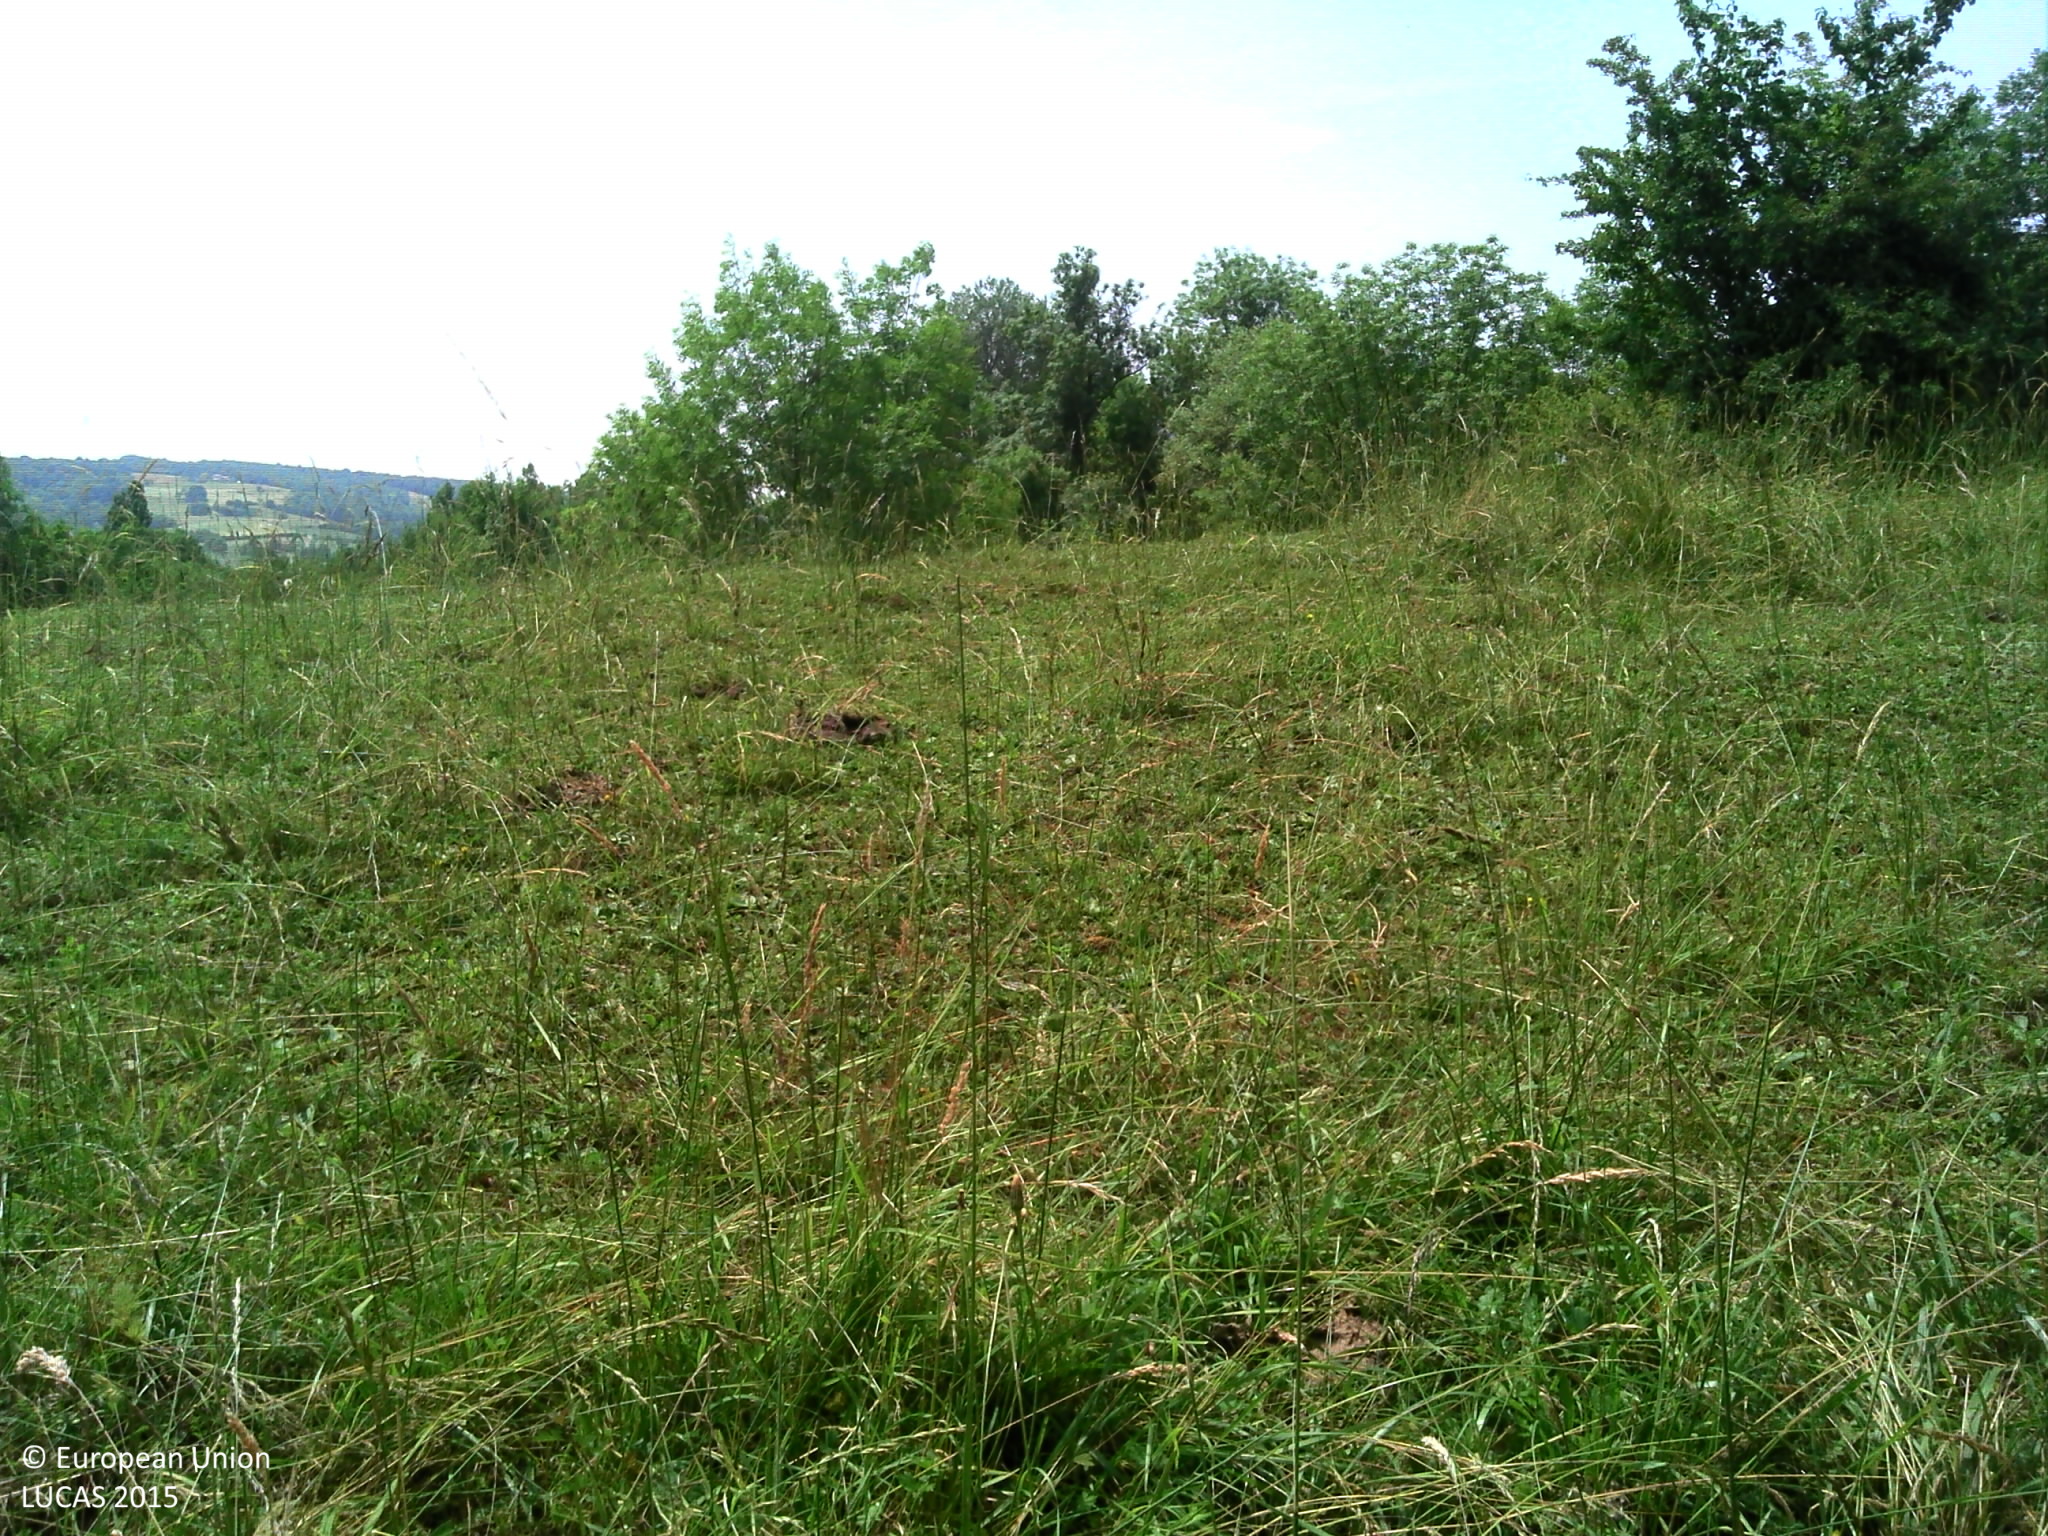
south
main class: Grassland
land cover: Grassland without tree/shrub cover
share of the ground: > 75 %
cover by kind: herbaceous plants 100 %
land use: Agriculture (excluding fallow land and kitchen gardens)
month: June
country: FR
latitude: 45.2606
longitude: 5.0221
